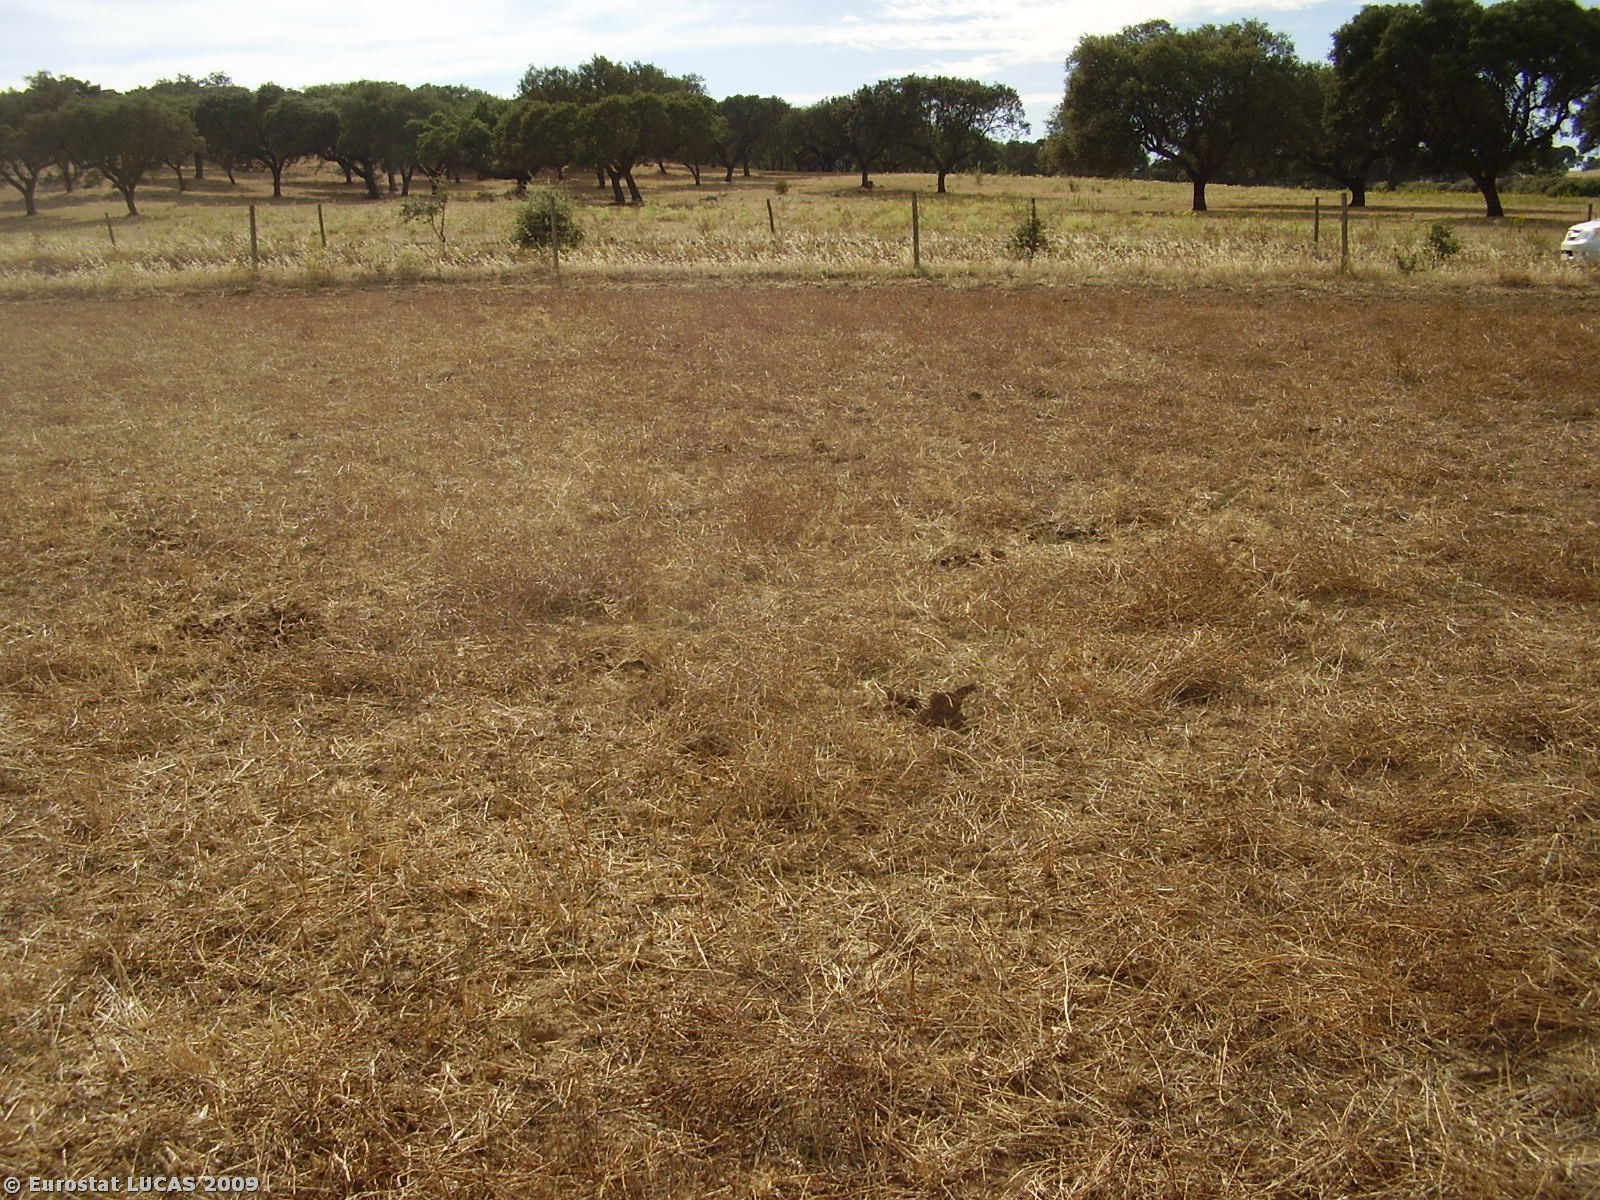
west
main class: Grassland
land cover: Grassland without tree/shrub cover
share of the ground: > 75 %
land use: Agriculture (excluding fallow land and kitchen gardens)
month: July
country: PT
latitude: 38.6895
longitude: -7.8485
